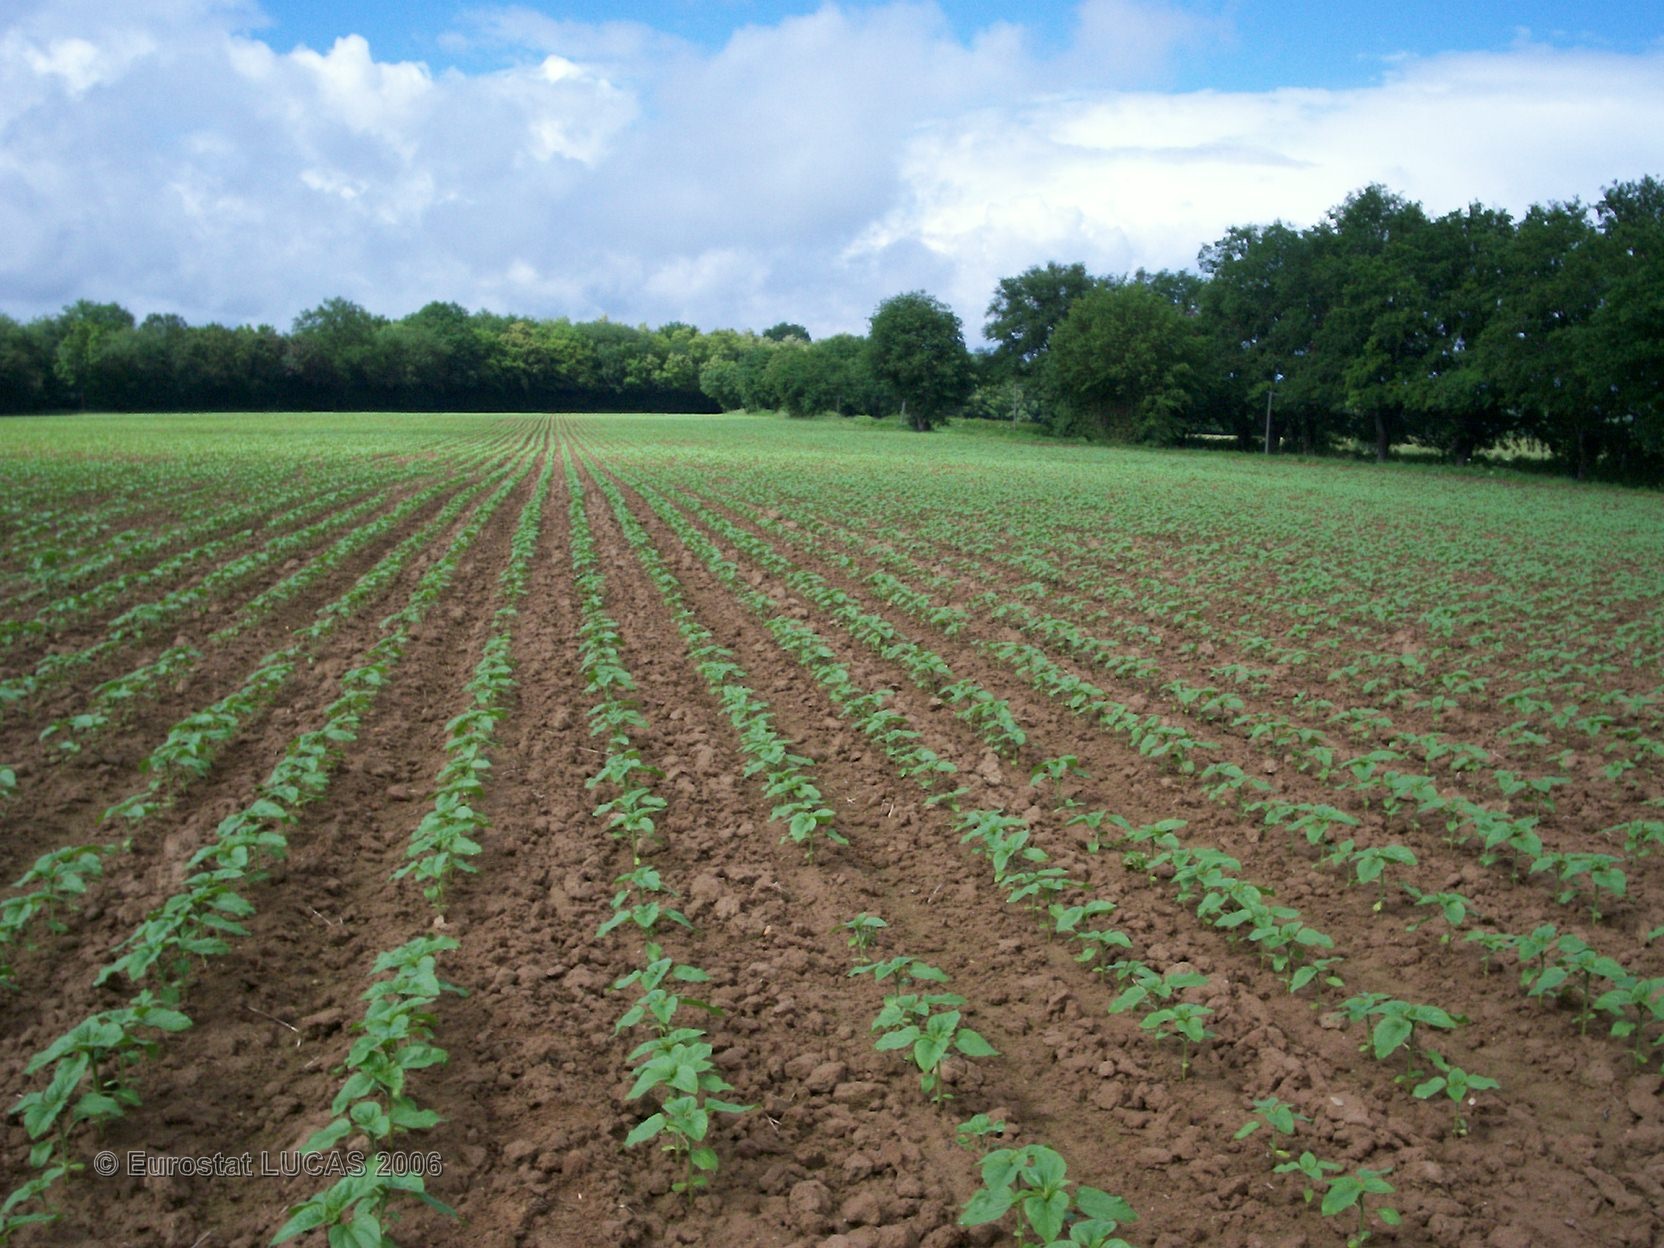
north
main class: Cropland
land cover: Sunflower
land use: Agriculture (excluding fallow land and kitchen gardens)
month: May
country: FR
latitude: 47.1514
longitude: 2.9922
